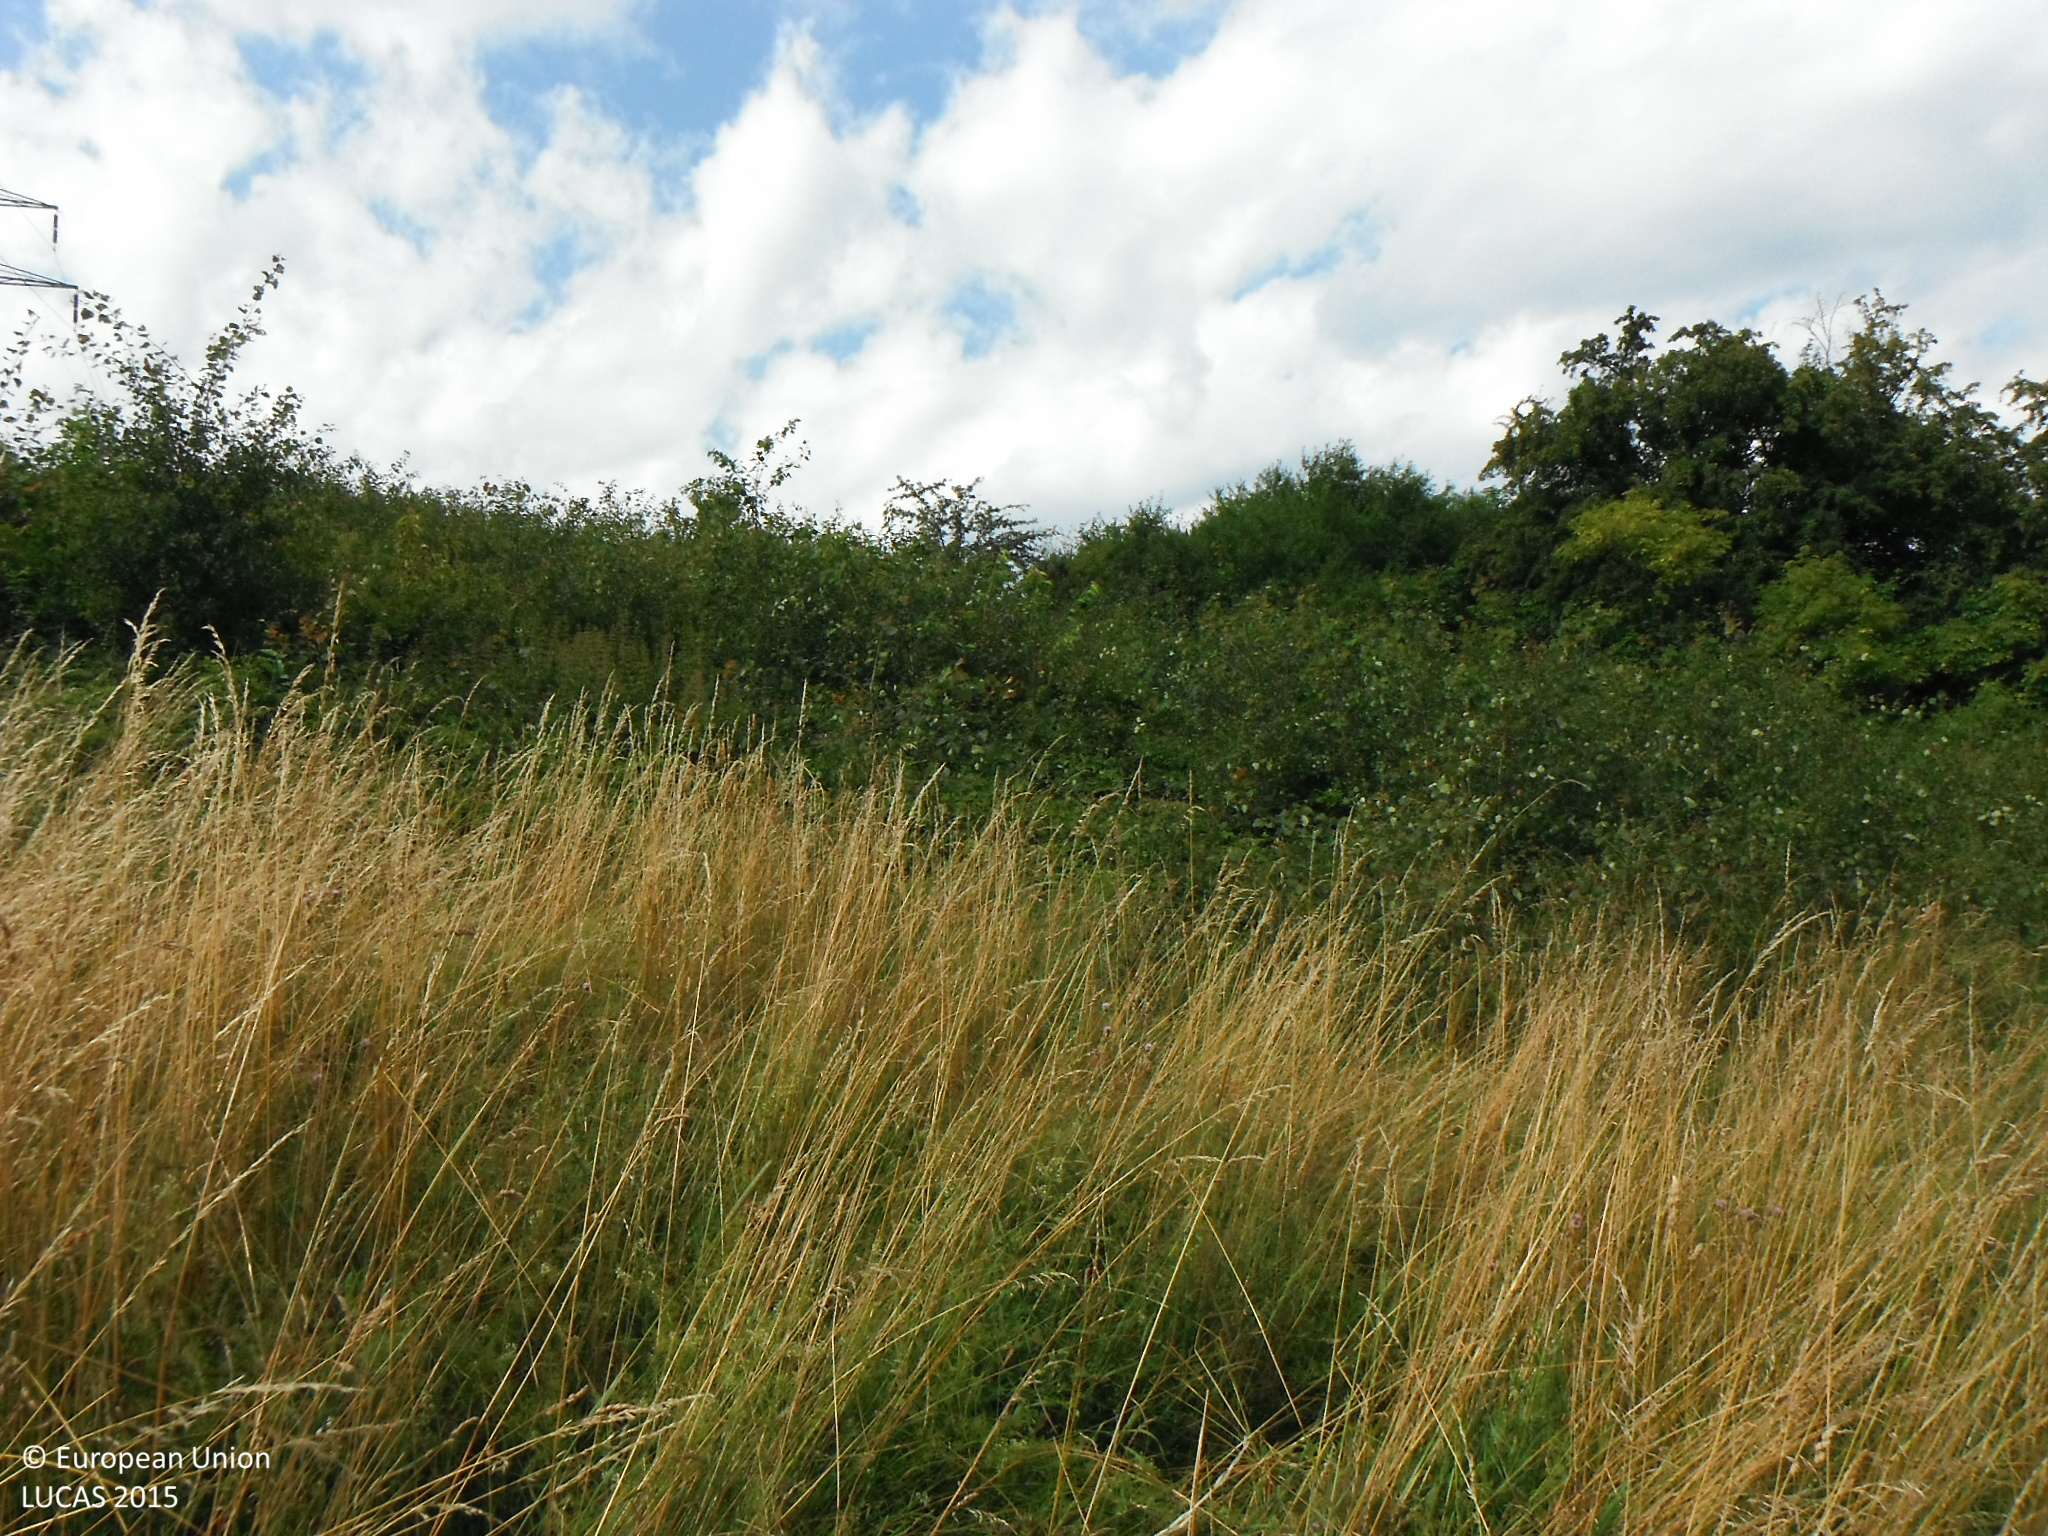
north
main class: Grassland
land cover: Spontaneously vegetated surfaces
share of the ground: > 75 %
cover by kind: herbaceous plants 95 %, shrubs 5 %
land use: Abandoned areas
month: July
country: SK
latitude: 48.7275
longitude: 21.1500
